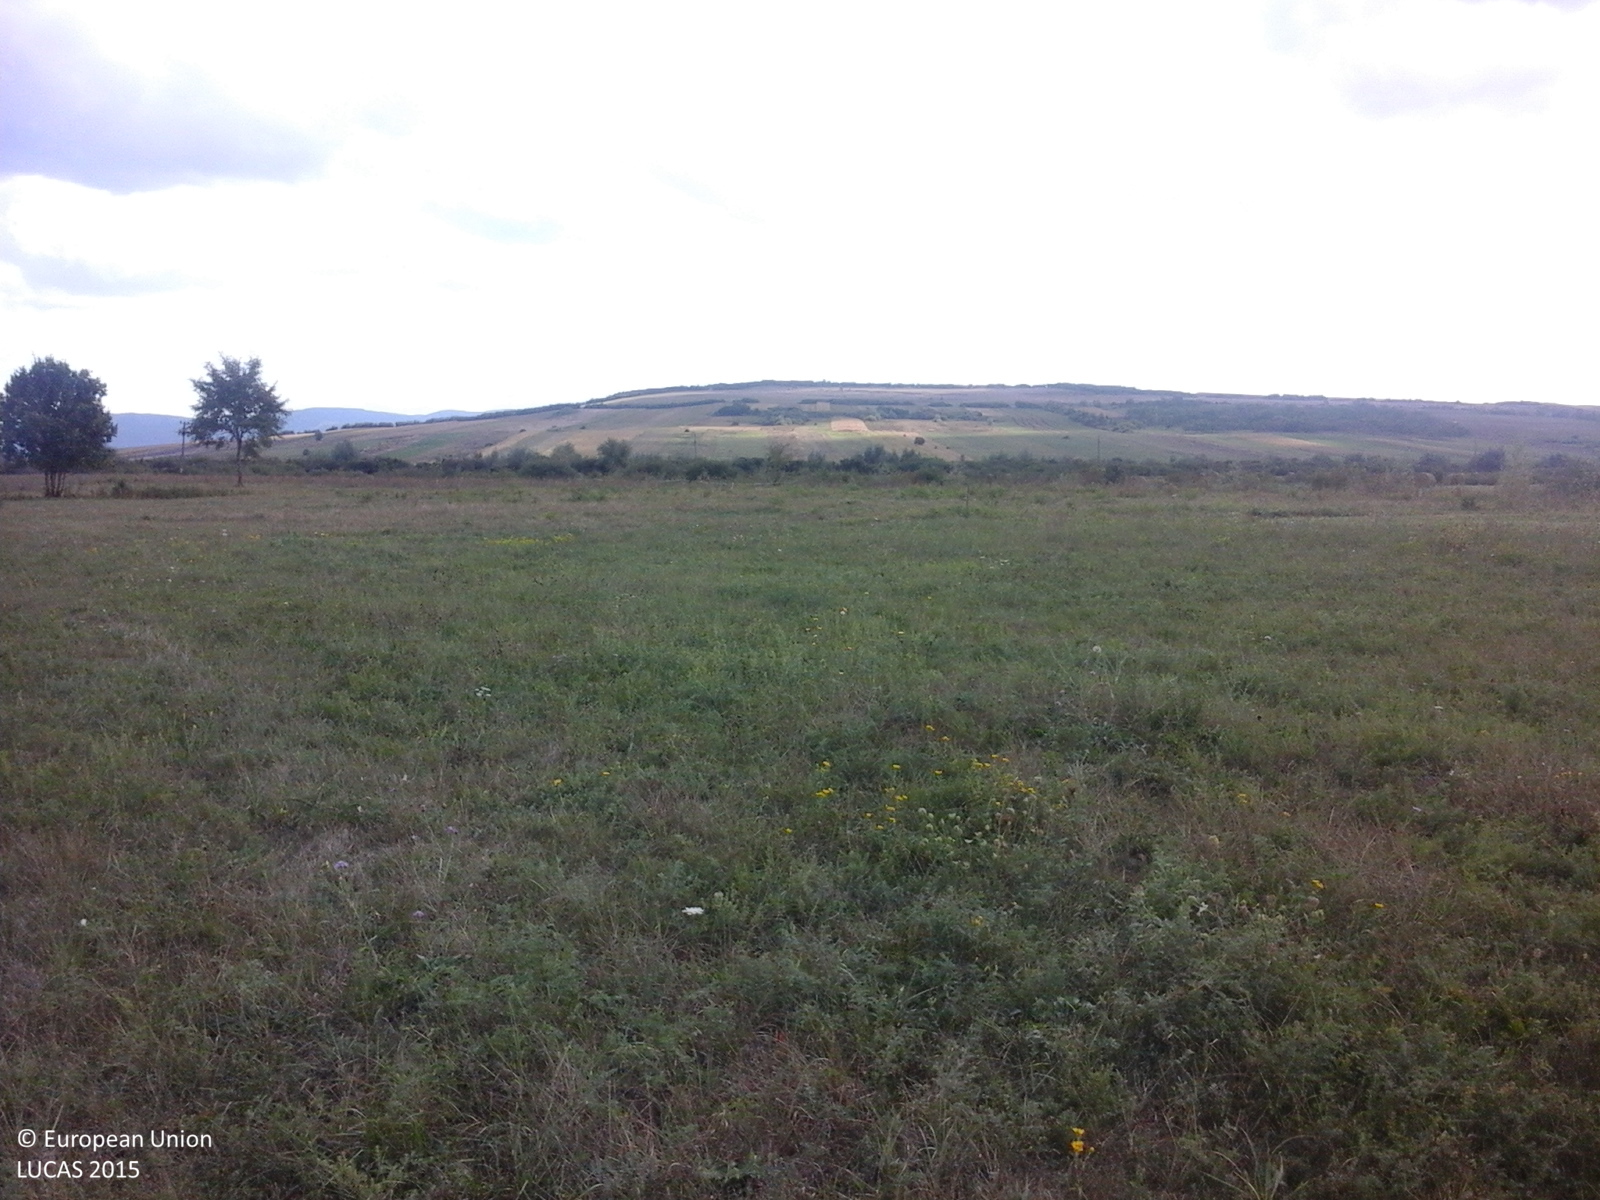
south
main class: Grassland
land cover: Grassland without tree/shrub cover
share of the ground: > 75 %
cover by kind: herbaceous plants 100 %
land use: Agriculture (excluding fallow land and kitchen gardens)
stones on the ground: < 10 %
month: September
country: RO
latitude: 47.5101
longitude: 23.2543
